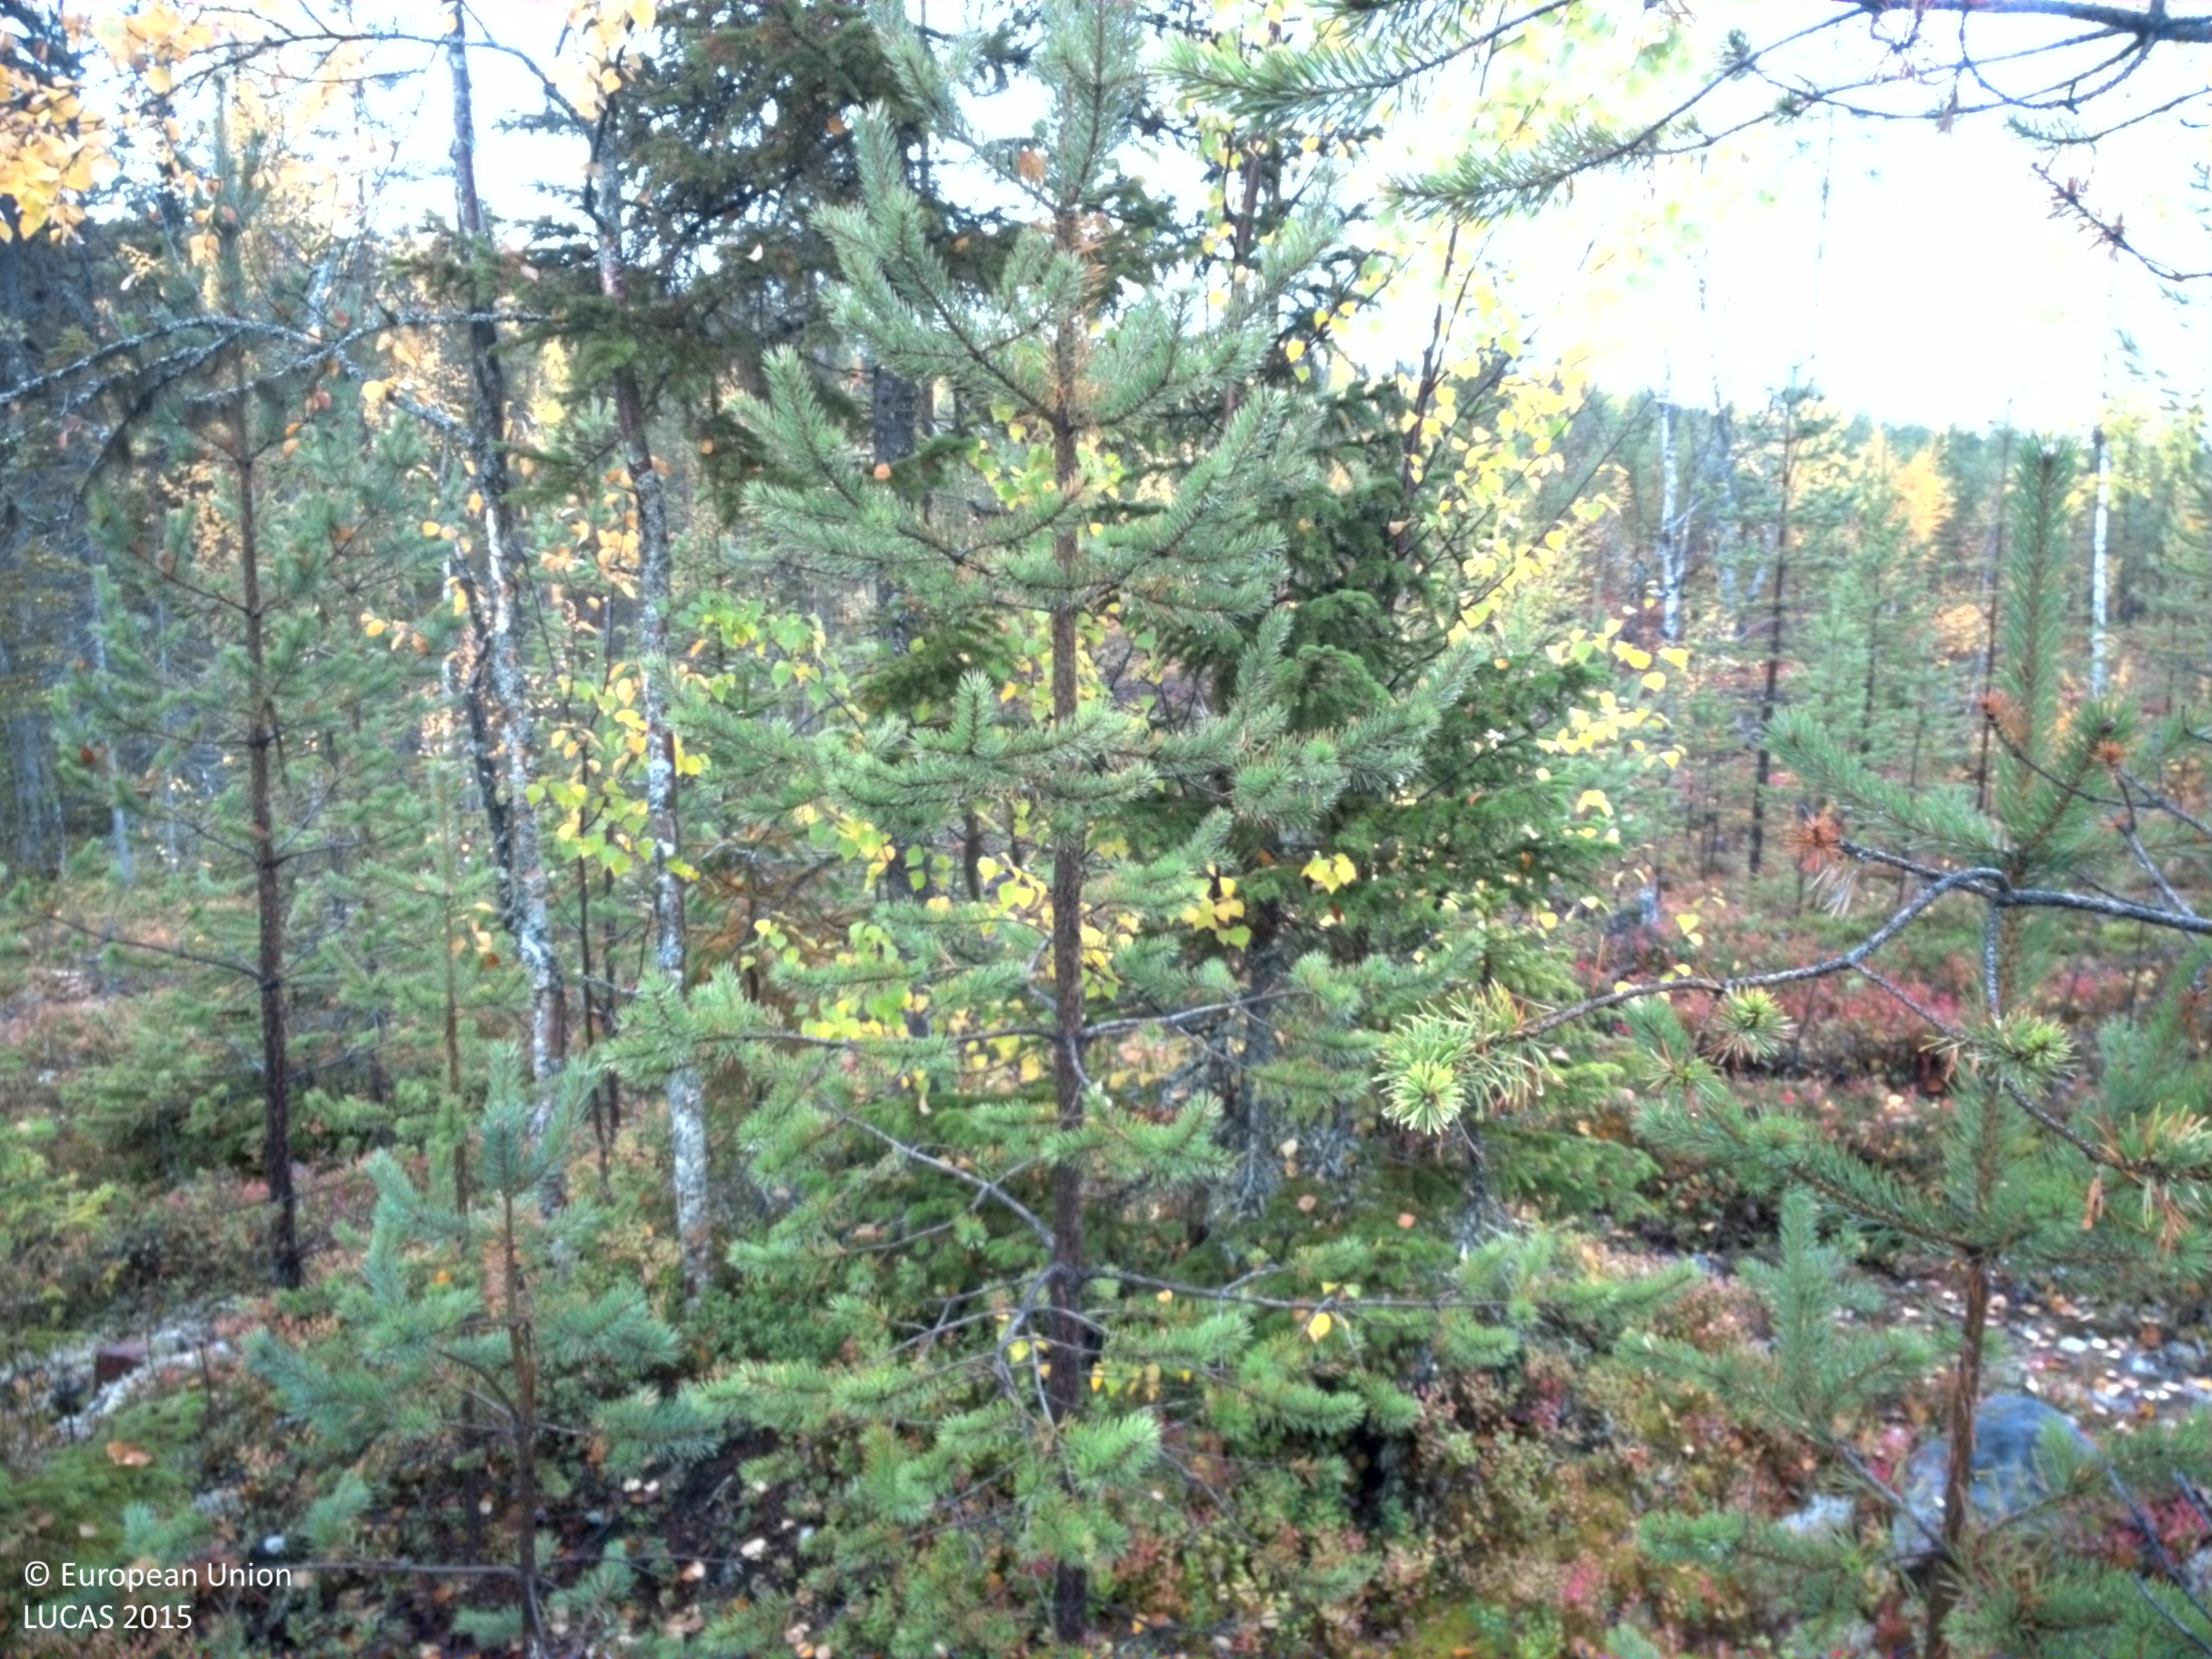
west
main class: Woodland
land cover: Pine dominated coniferous woodland
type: boreal forest
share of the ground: 25 - 50 %
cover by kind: shrubs 40 %, lichens and mosses 30 %, coniferous forest trees 20 %, broadleaved forest trees 5 %, unconsolidated bare surface 5 %
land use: Forestry
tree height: > 5 m
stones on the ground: < 10 %
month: September
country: SE
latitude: 65.0934
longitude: 17.4751
